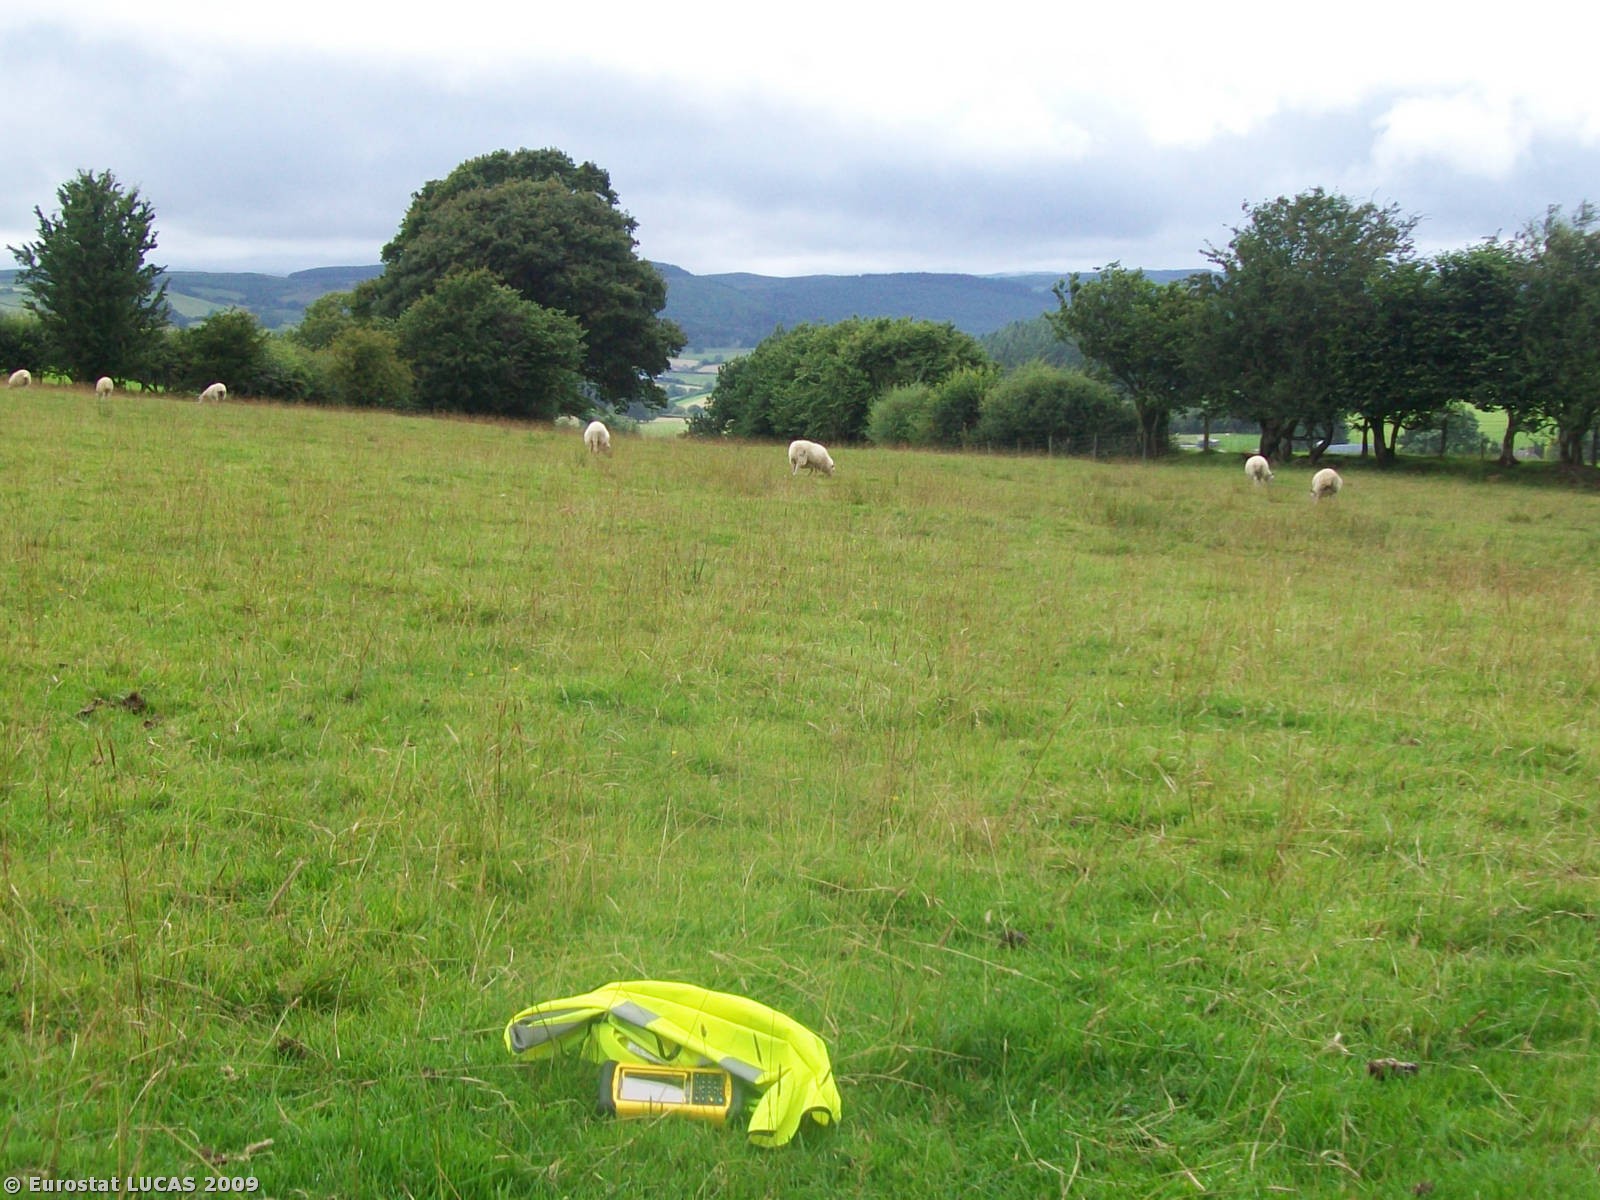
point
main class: Grassland
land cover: Grassland without tree/shrub cover
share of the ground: > 75 %
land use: Agriculture (excluding fallow land and kitchen gardens)
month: August
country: GB
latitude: 52.7264
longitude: -3.3937
